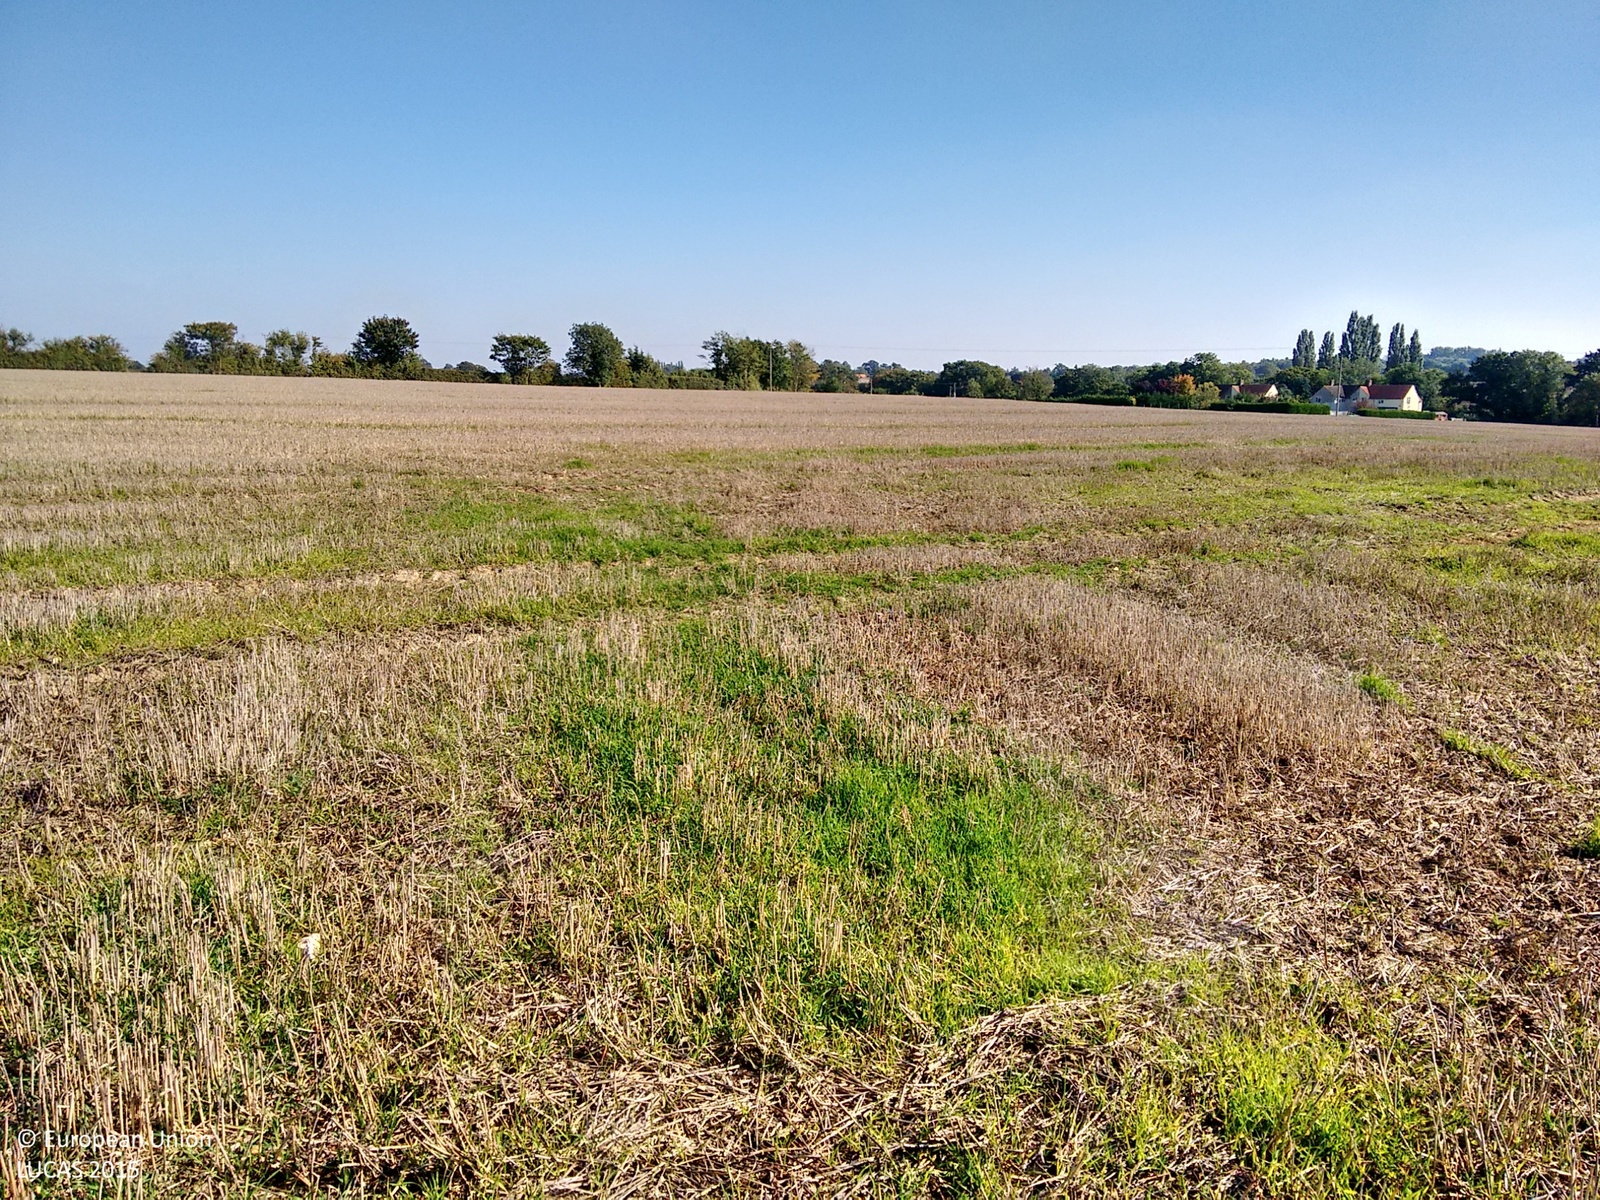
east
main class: Cropland
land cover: Common wheat
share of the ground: > 75 %
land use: Agriculture (excluding fallow land and kitchen gardens)
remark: Harvested field
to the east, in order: Common wheat; Electric lines; Common wheat; Grassland without tree/shrub cover
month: October
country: GB
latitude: 52.3566
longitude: 0.9464
